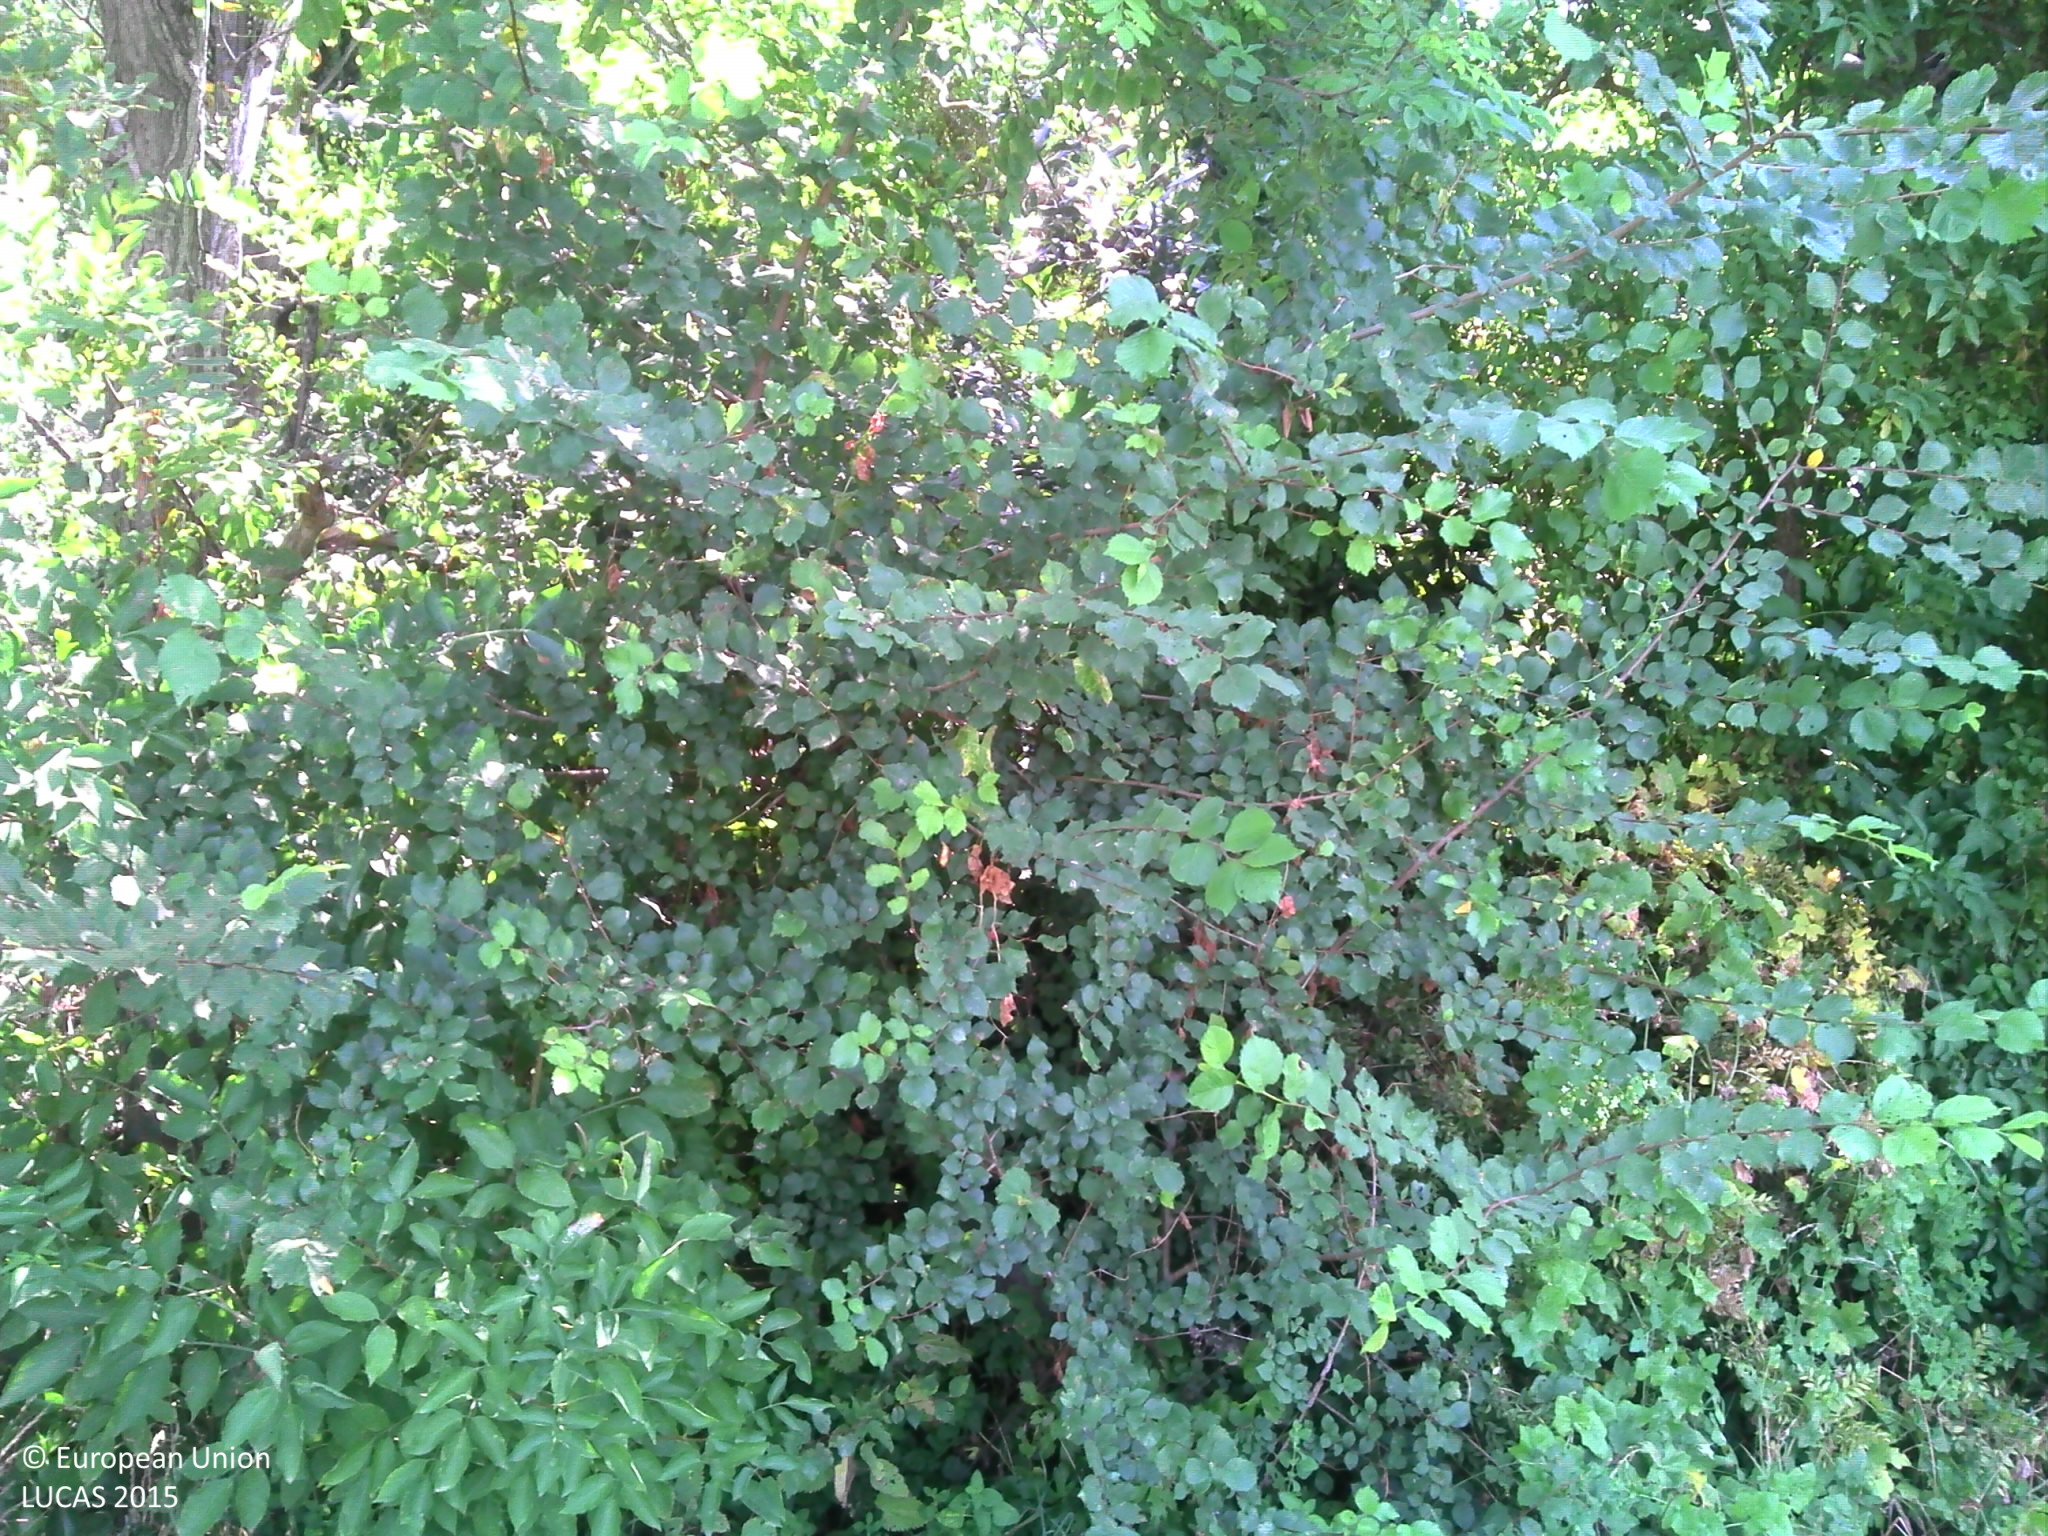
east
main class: Woodland
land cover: Pine dominated mixed woodland
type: thermophilous deciduous forest
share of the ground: > 75 %
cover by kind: broadleaved forest trees 75 %, coniferous forest trees 25 %
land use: Residential
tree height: > 5 m
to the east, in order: Pine dominated mixed woodland; Artificial constructions in urban areas; Broadleaved woodland; Vineyards; Tracks
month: July
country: FR
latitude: 43.1450
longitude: 2.1262
